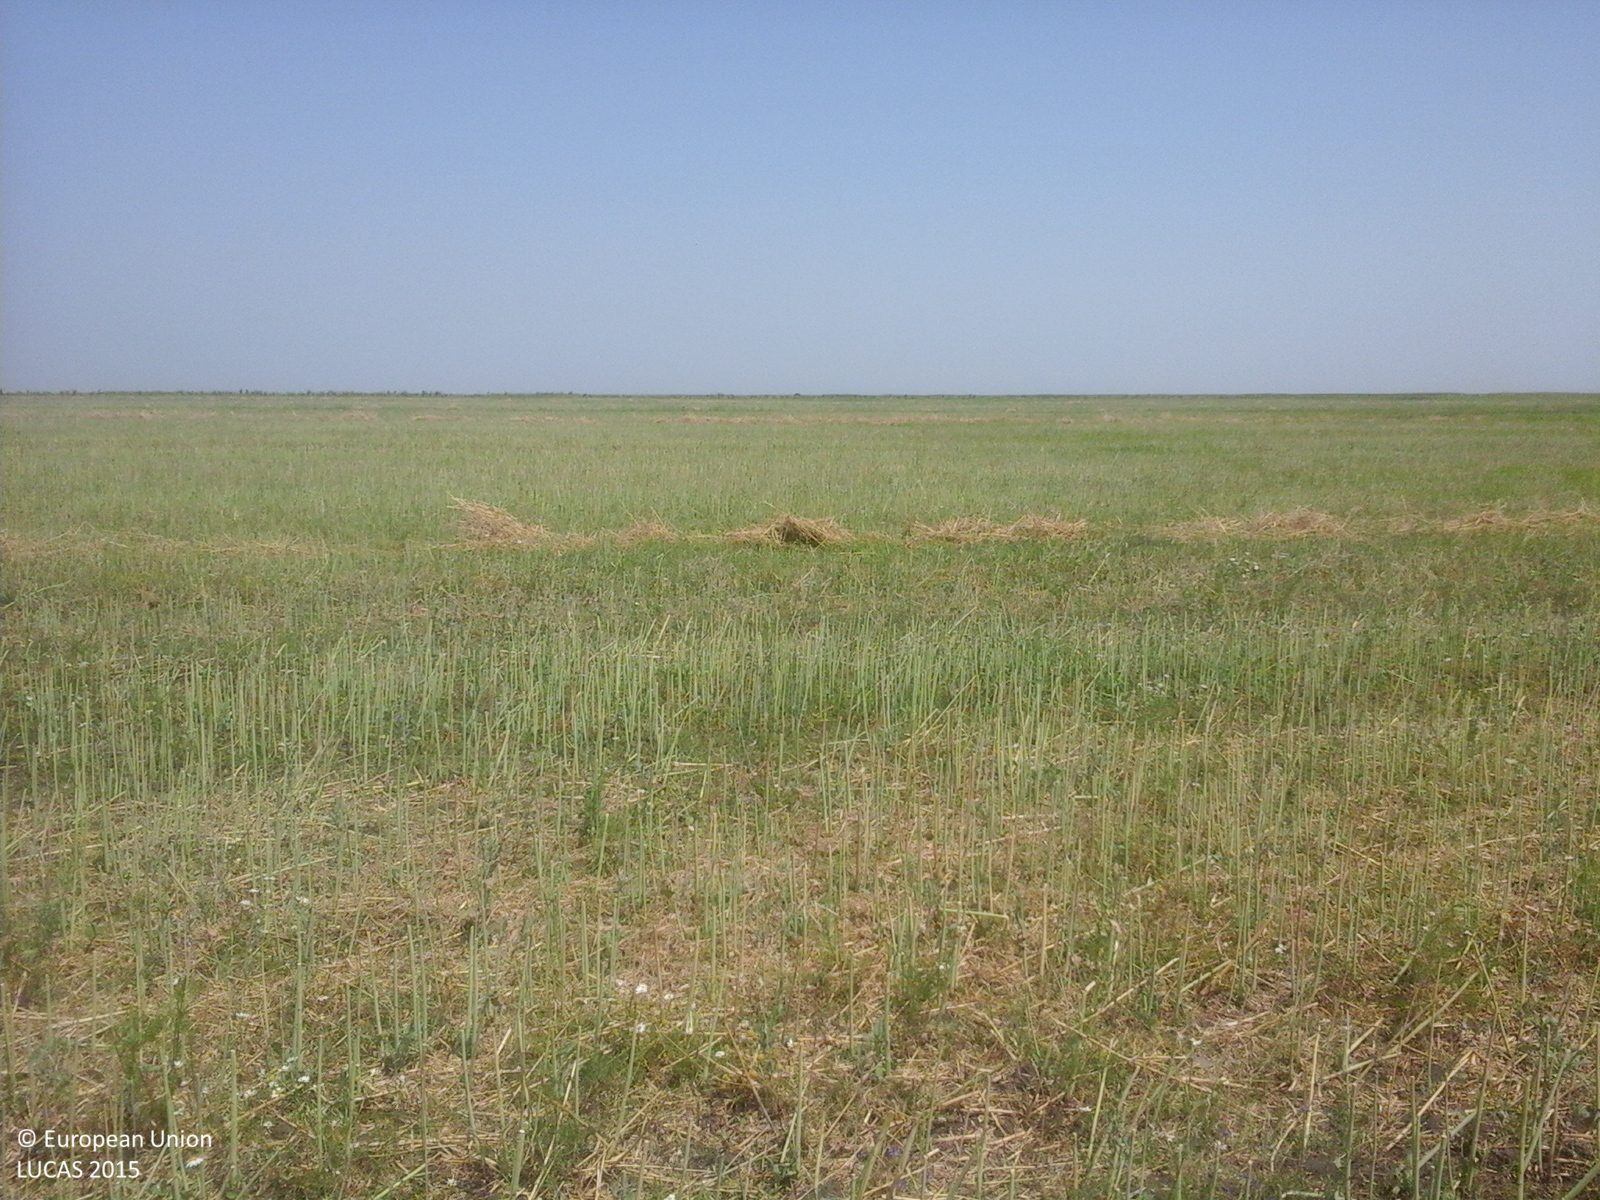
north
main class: Cropland
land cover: Rape and turnip rape
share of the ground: 10 - 25 %
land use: Agriculture (excluding fallow land and kitchen gardens)
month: July
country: RO
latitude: 44.4518
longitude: 24.8175
